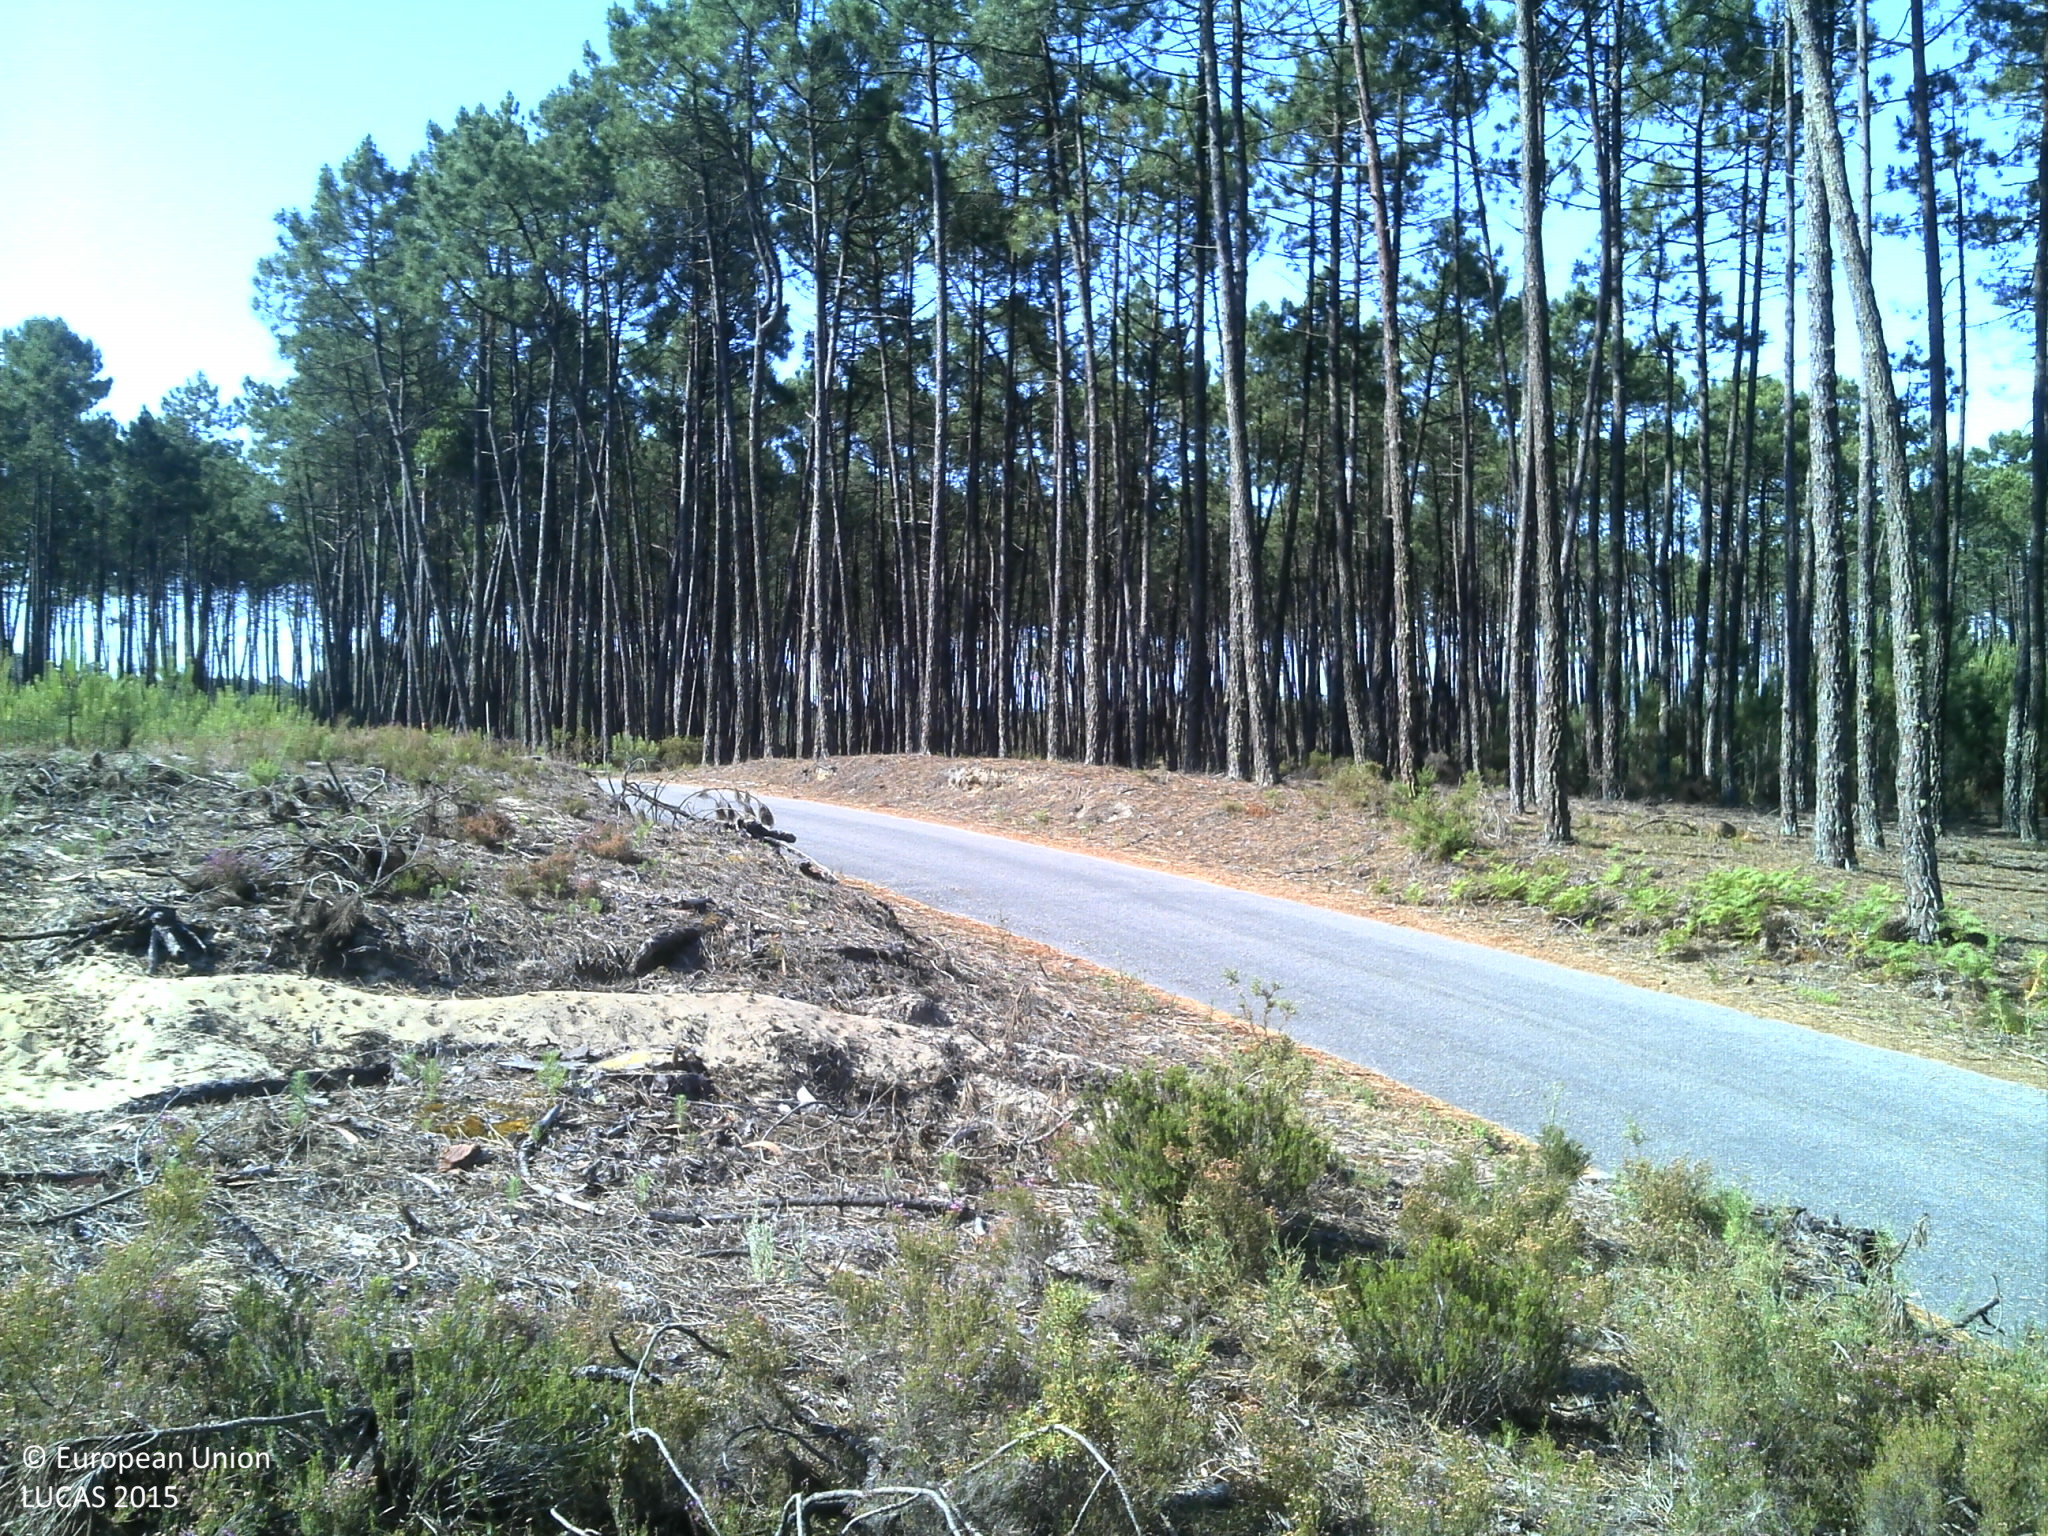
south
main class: Shrubland
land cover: Shrubland without tree cover
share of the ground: 50 - 75 %
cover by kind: shrubs 70 %, unconsolidated bare surface 25 %, herbaceous plants 5 %
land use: Forestry
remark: Clear cut
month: June
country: PT
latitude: 40.3775
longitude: -8.6922
